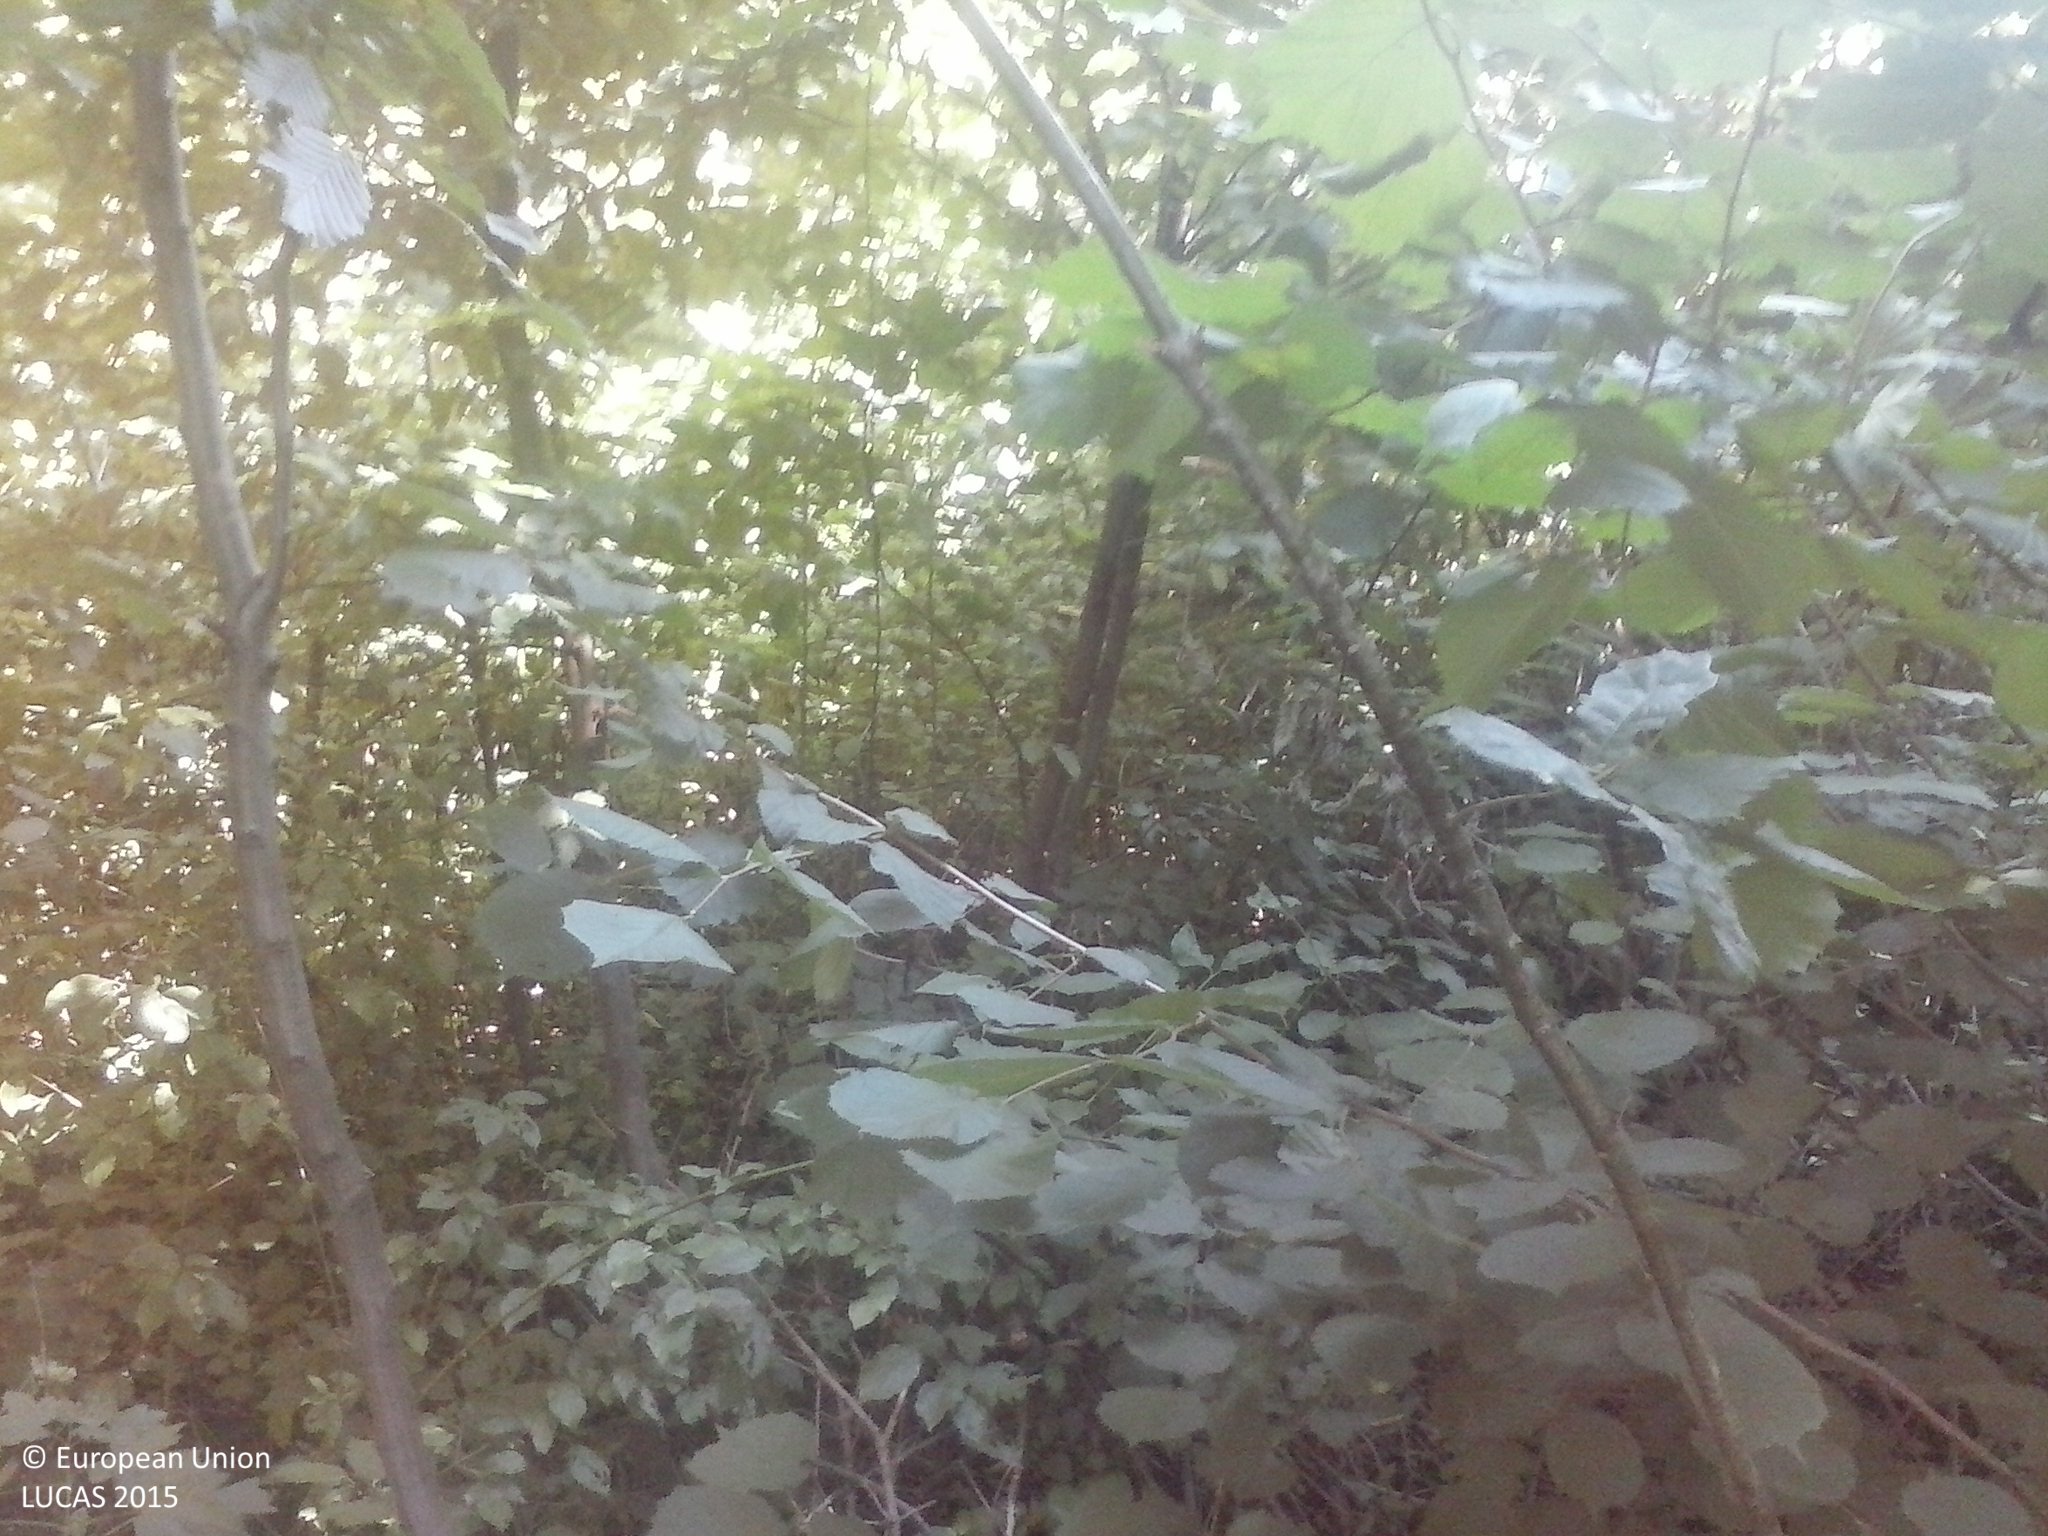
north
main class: Woodland
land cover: Broadleaved woodland
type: mesophytic deciduous forest
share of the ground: > 75 %
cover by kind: broadleaved forest trees 90 %, shrubs 10 %
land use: Forestry
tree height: > 5 m
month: August
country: HU
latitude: 45.9274
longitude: 17.9617
